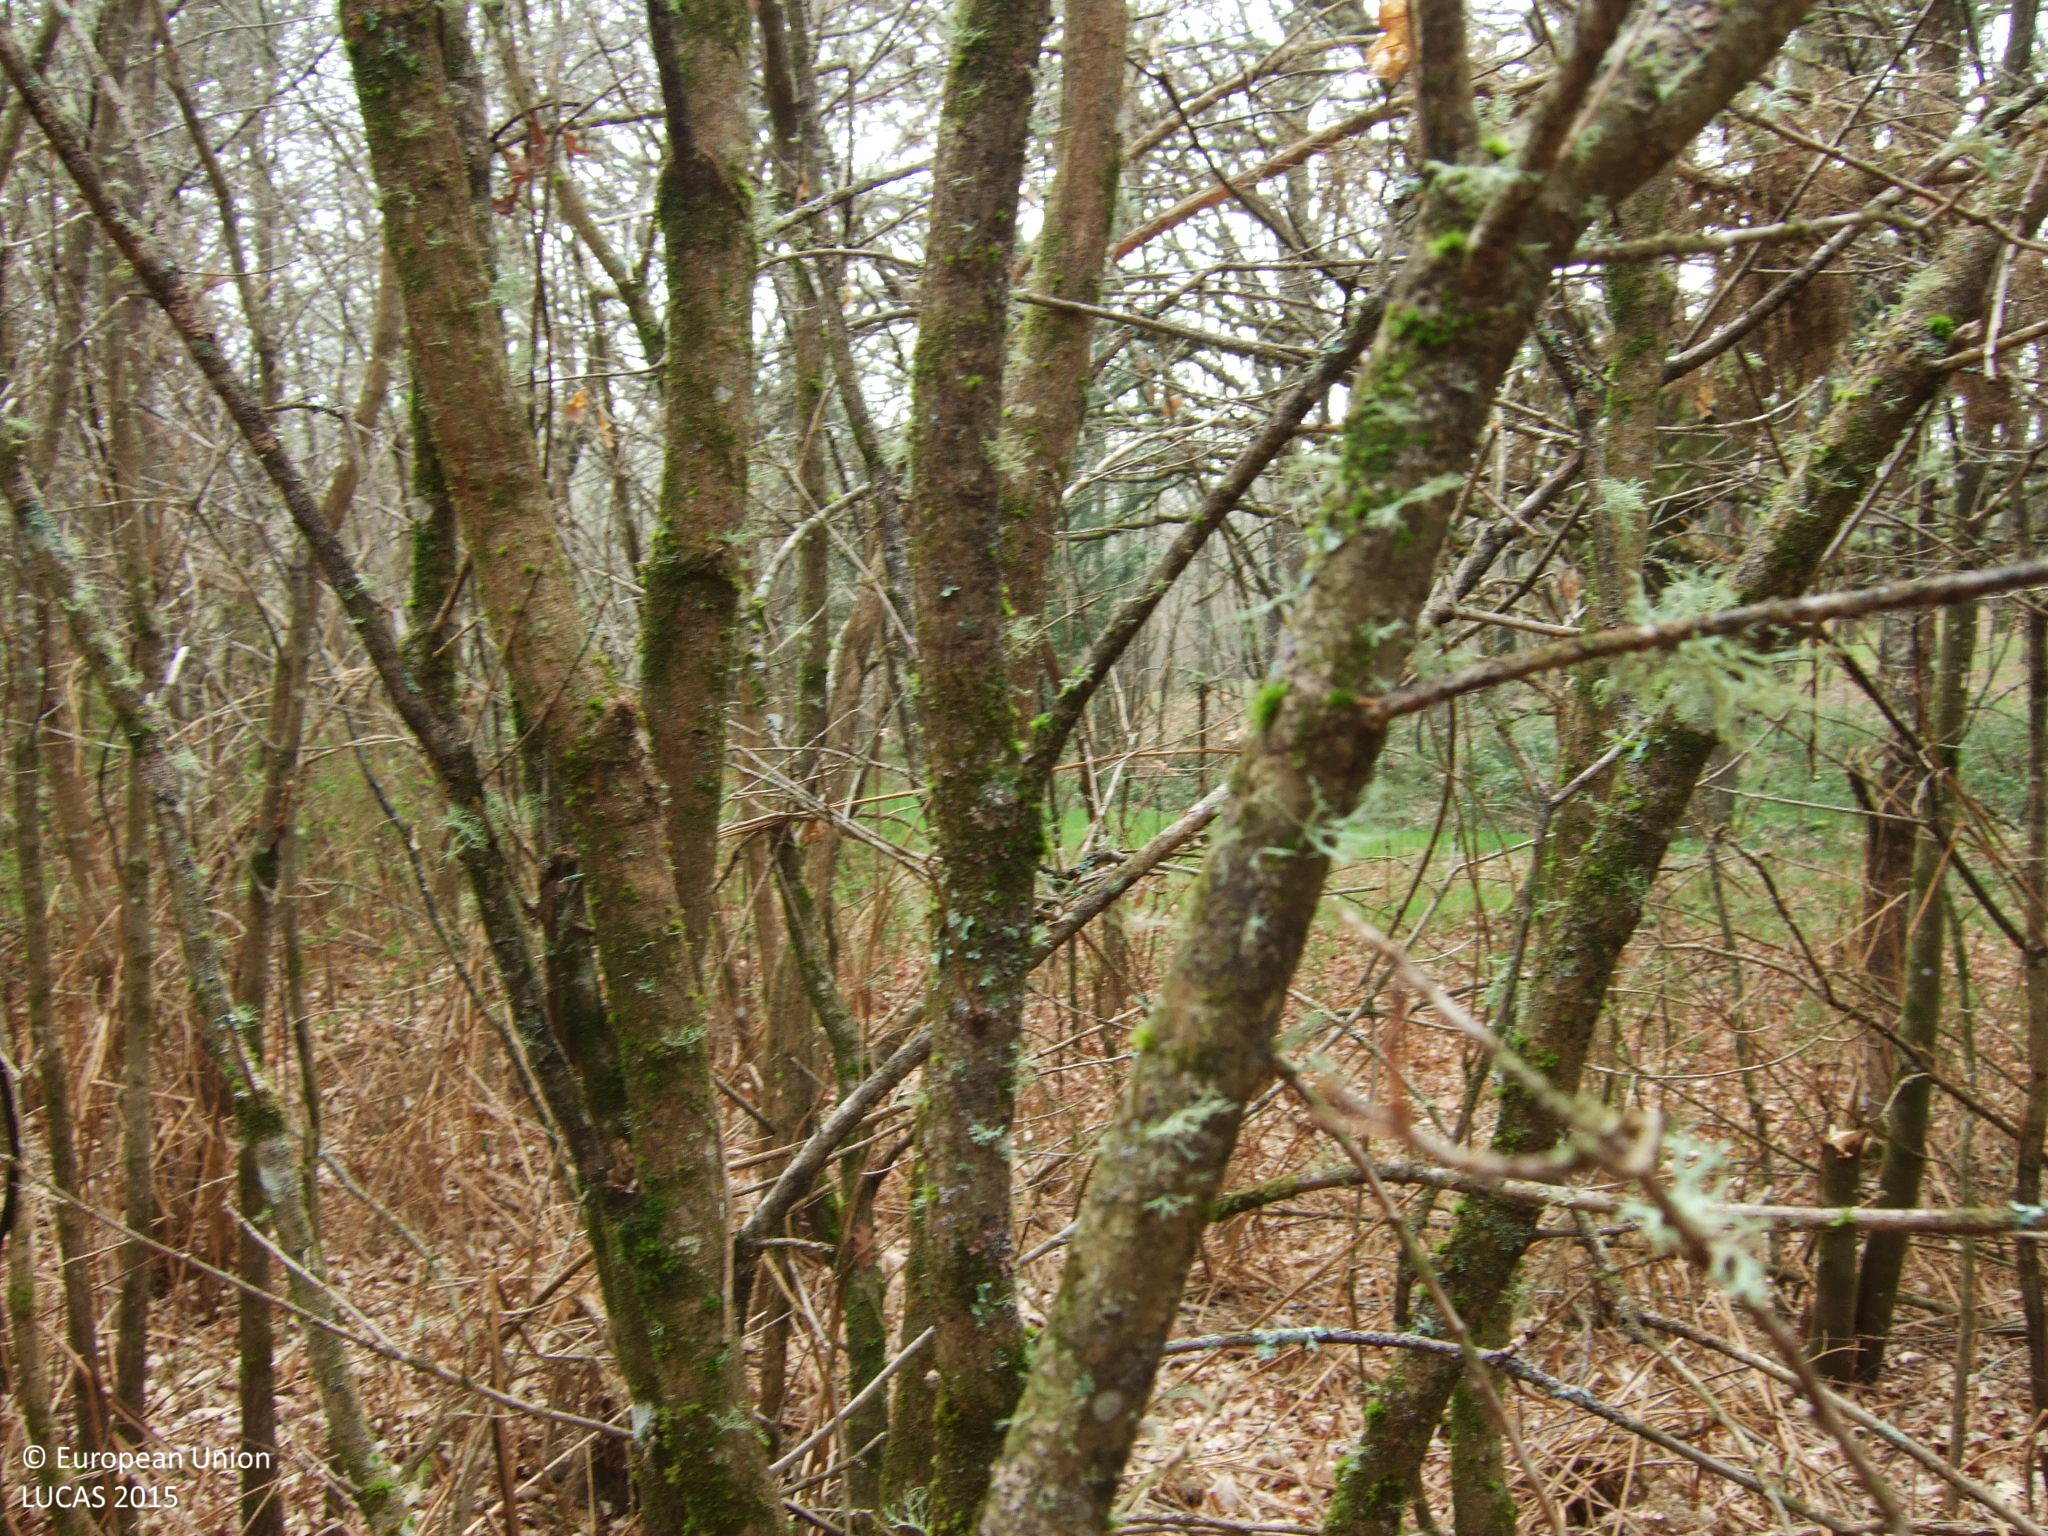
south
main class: Woodland
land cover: Broadleaved woodland
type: acidophilous oak and oak-birch forest
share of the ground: 50 - 75 %
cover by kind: broadleaved forest trees 70 %, shrubs 30 %
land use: Semi-natural and natural areas not in use
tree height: > 5 m
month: April
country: ES
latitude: 42.7750
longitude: -7.8160
